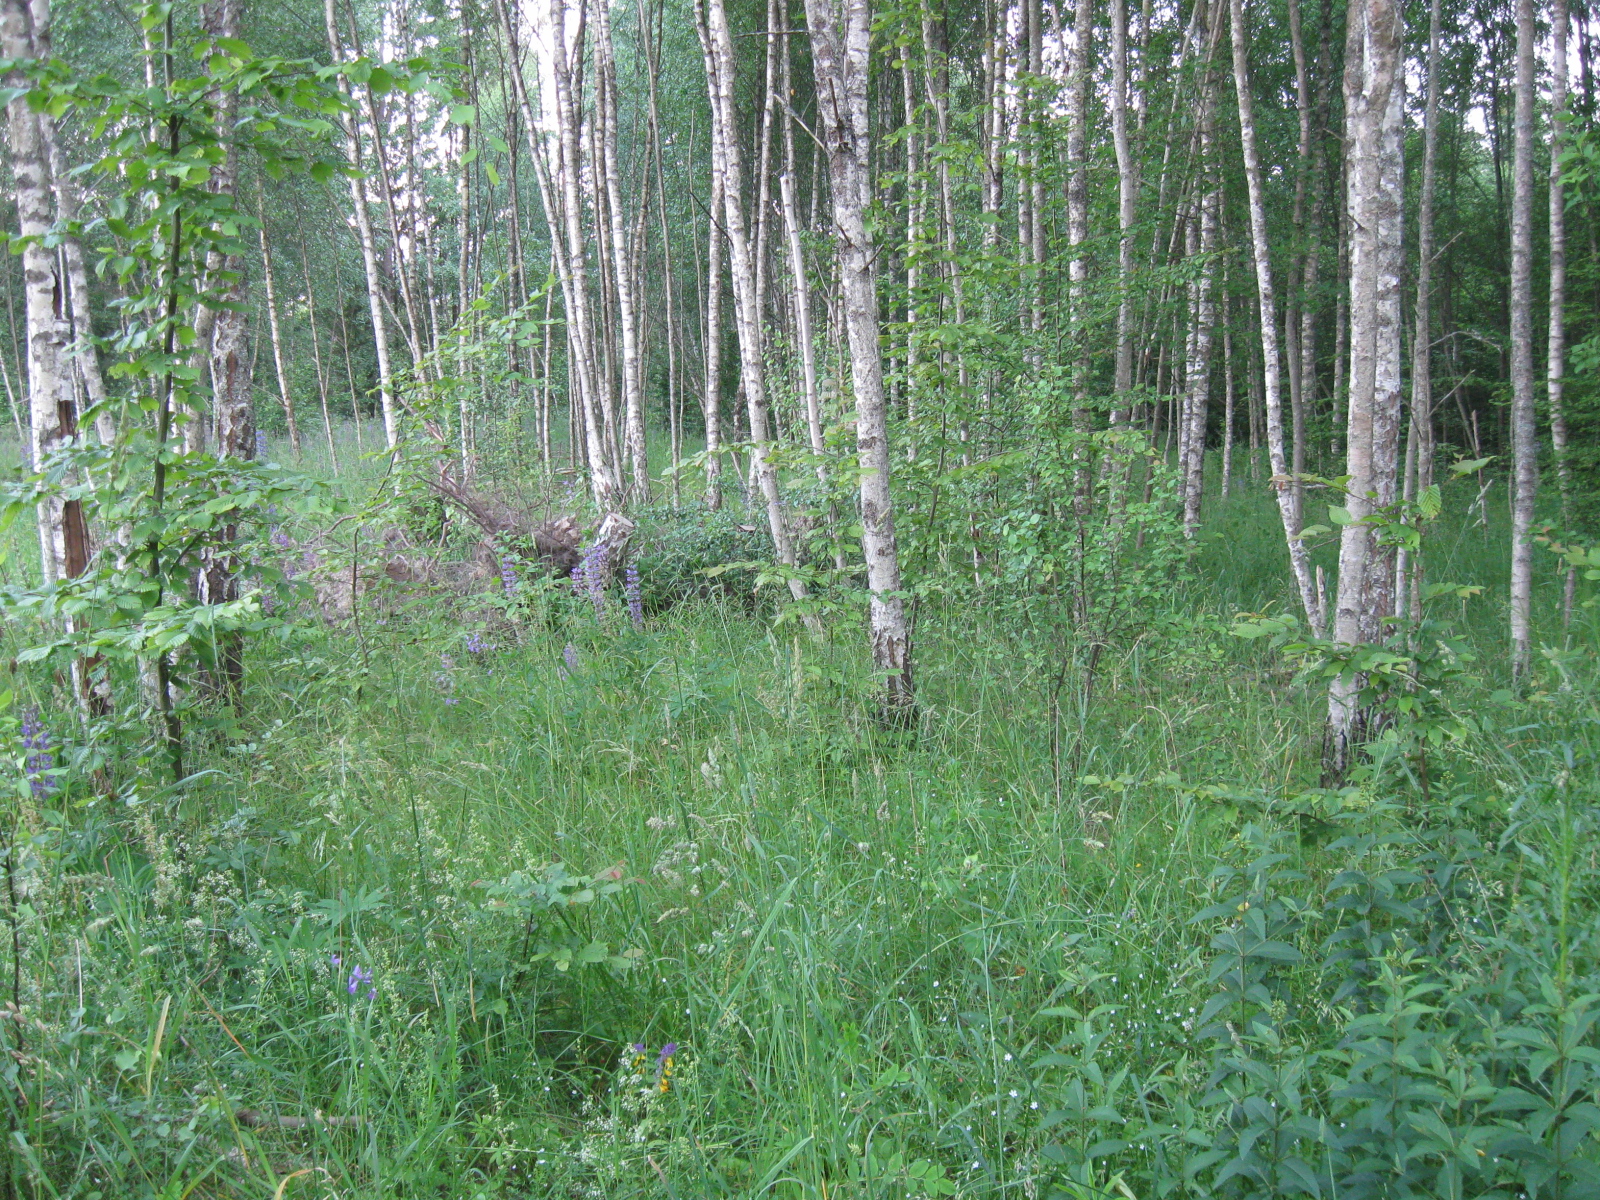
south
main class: Woodland
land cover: Broadleaved woodland
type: non-riverine alder, birch or aspen forest
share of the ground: 50 - 75 %
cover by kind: broadleaved forest trees 65 %, herbaceous plants 25 %, shrubs 10 %
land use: Forestry
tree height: > 5 m
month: June
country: LT
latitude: 54.1274
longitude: 24.6914
